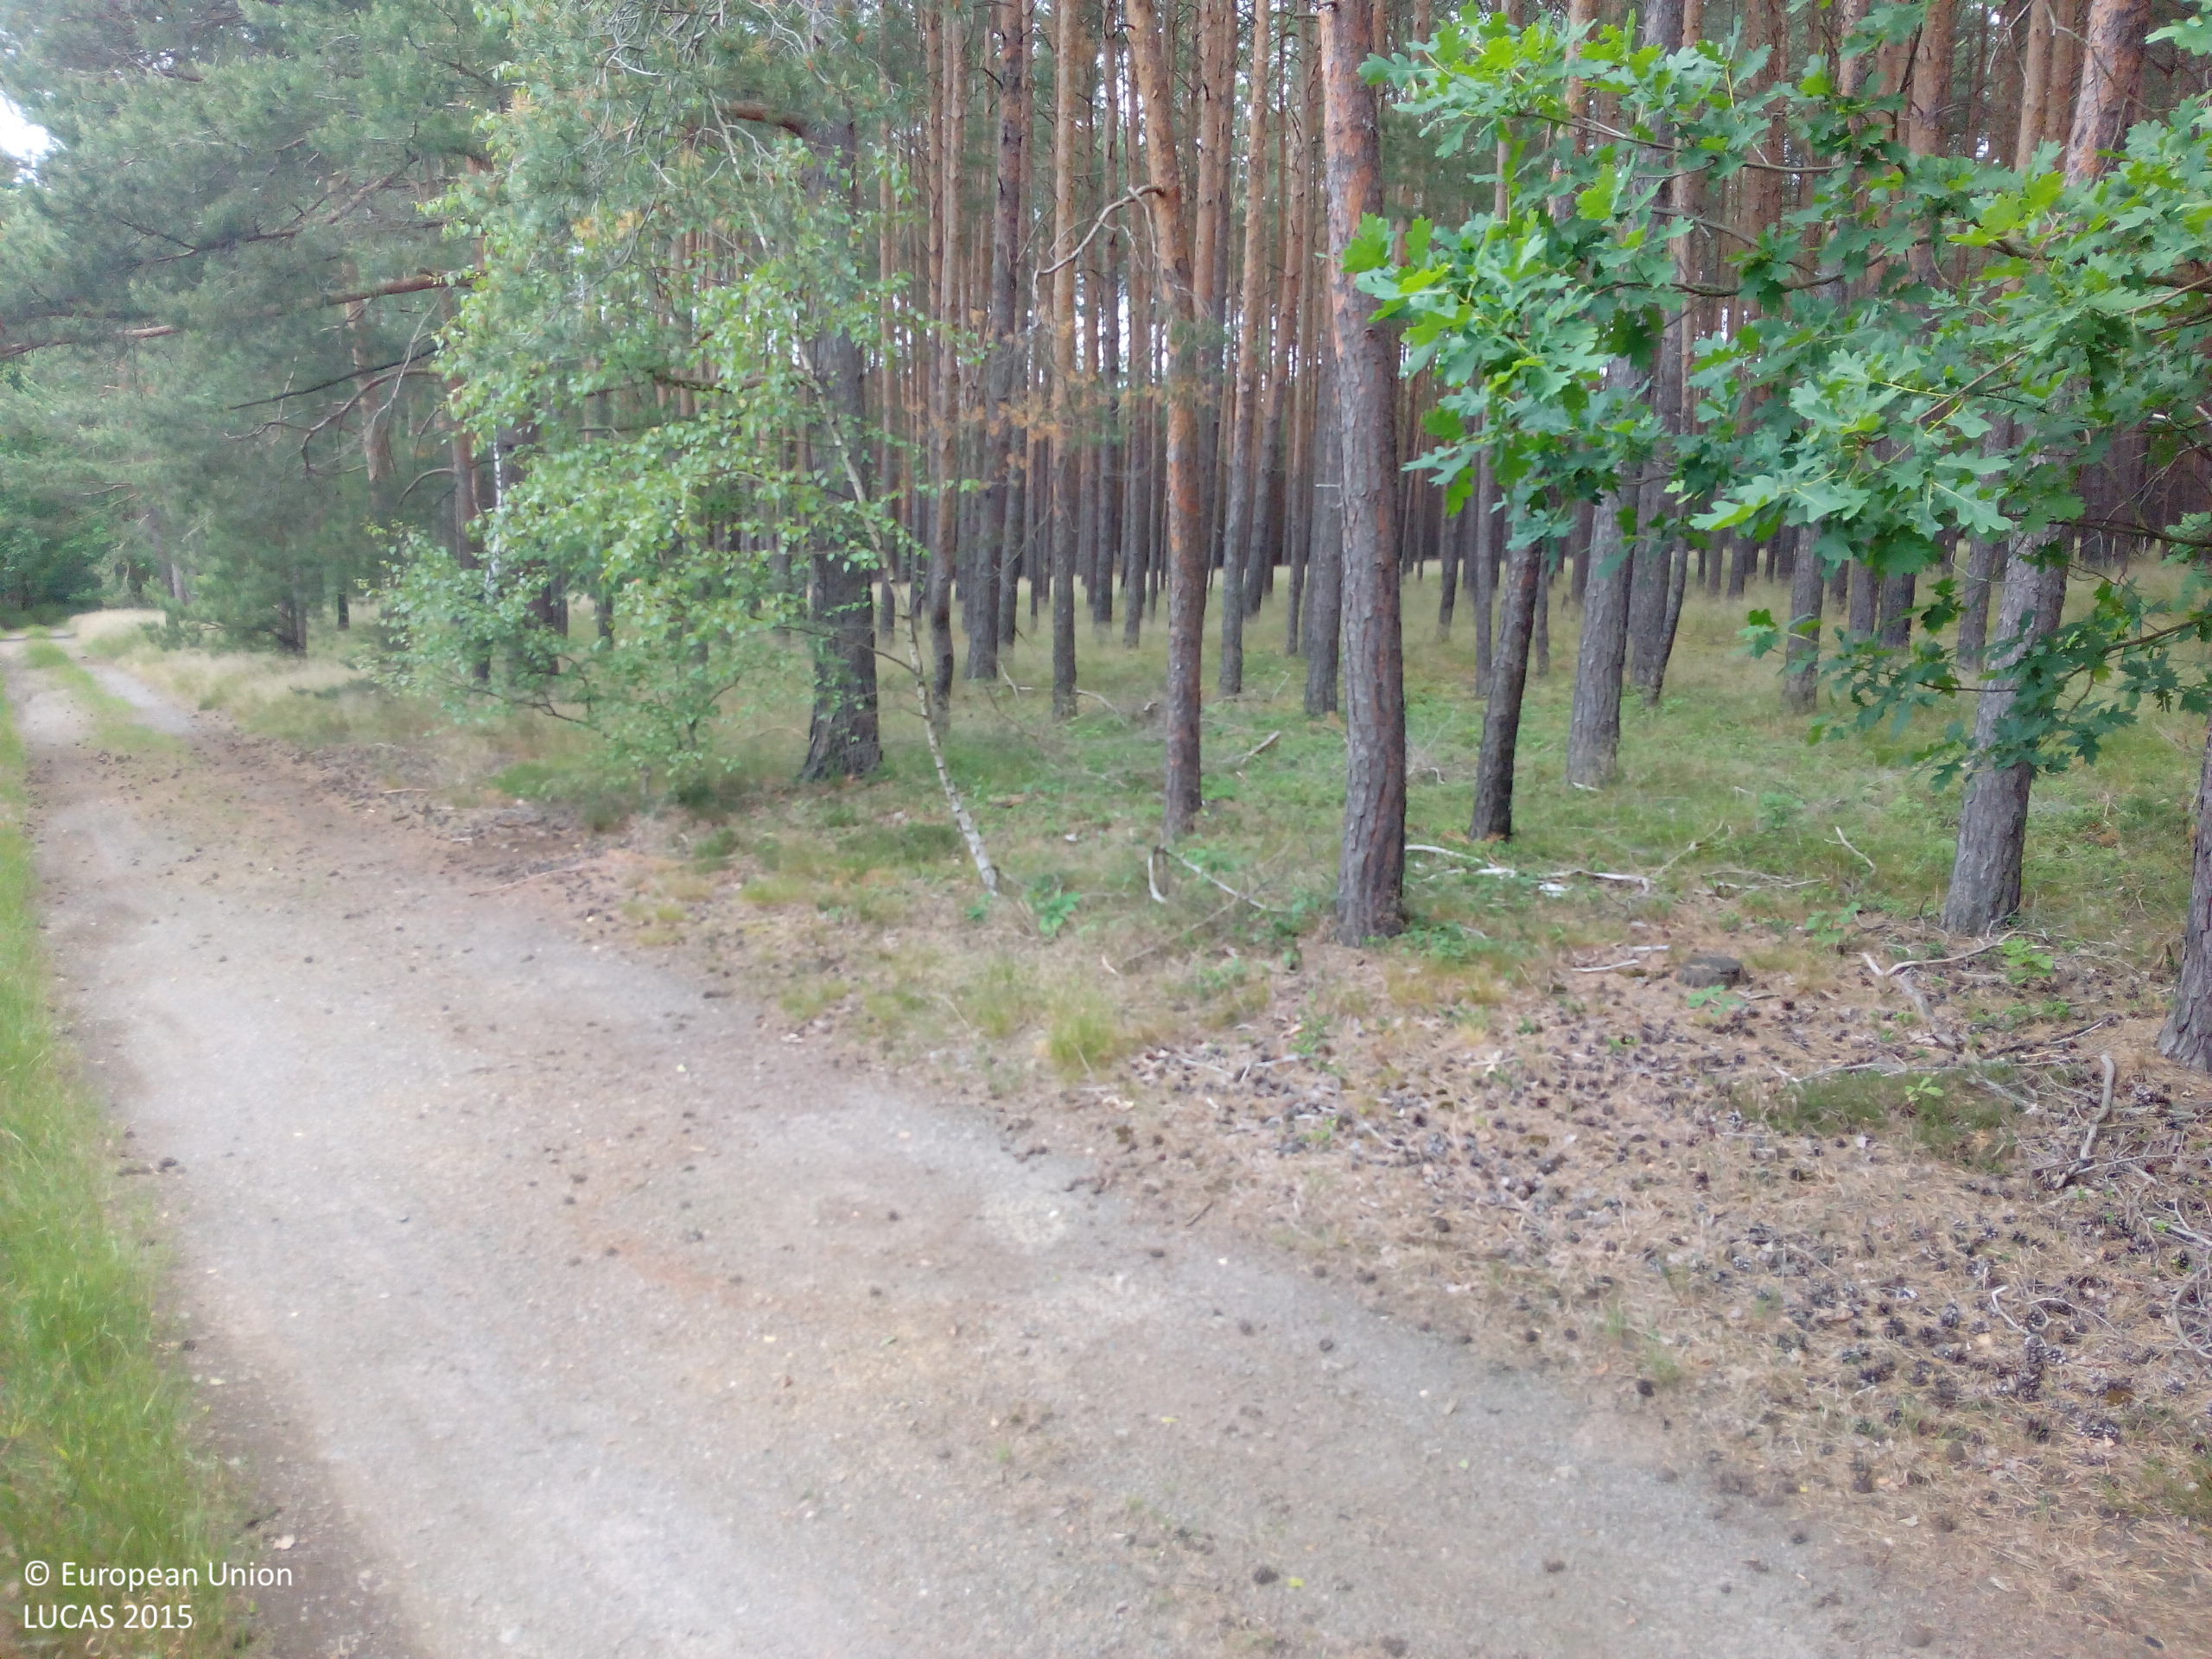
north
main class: Woodland
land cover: Pine dominated mixed woodland
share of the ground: > 75 %
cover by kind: coniferous forest trees 65 %, broadleaved forest trees 25 %, herbaceous plants 10 %
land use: Forestry
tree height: > 5 m
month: June
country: DE
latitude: 51.3560
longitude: 14.0075
